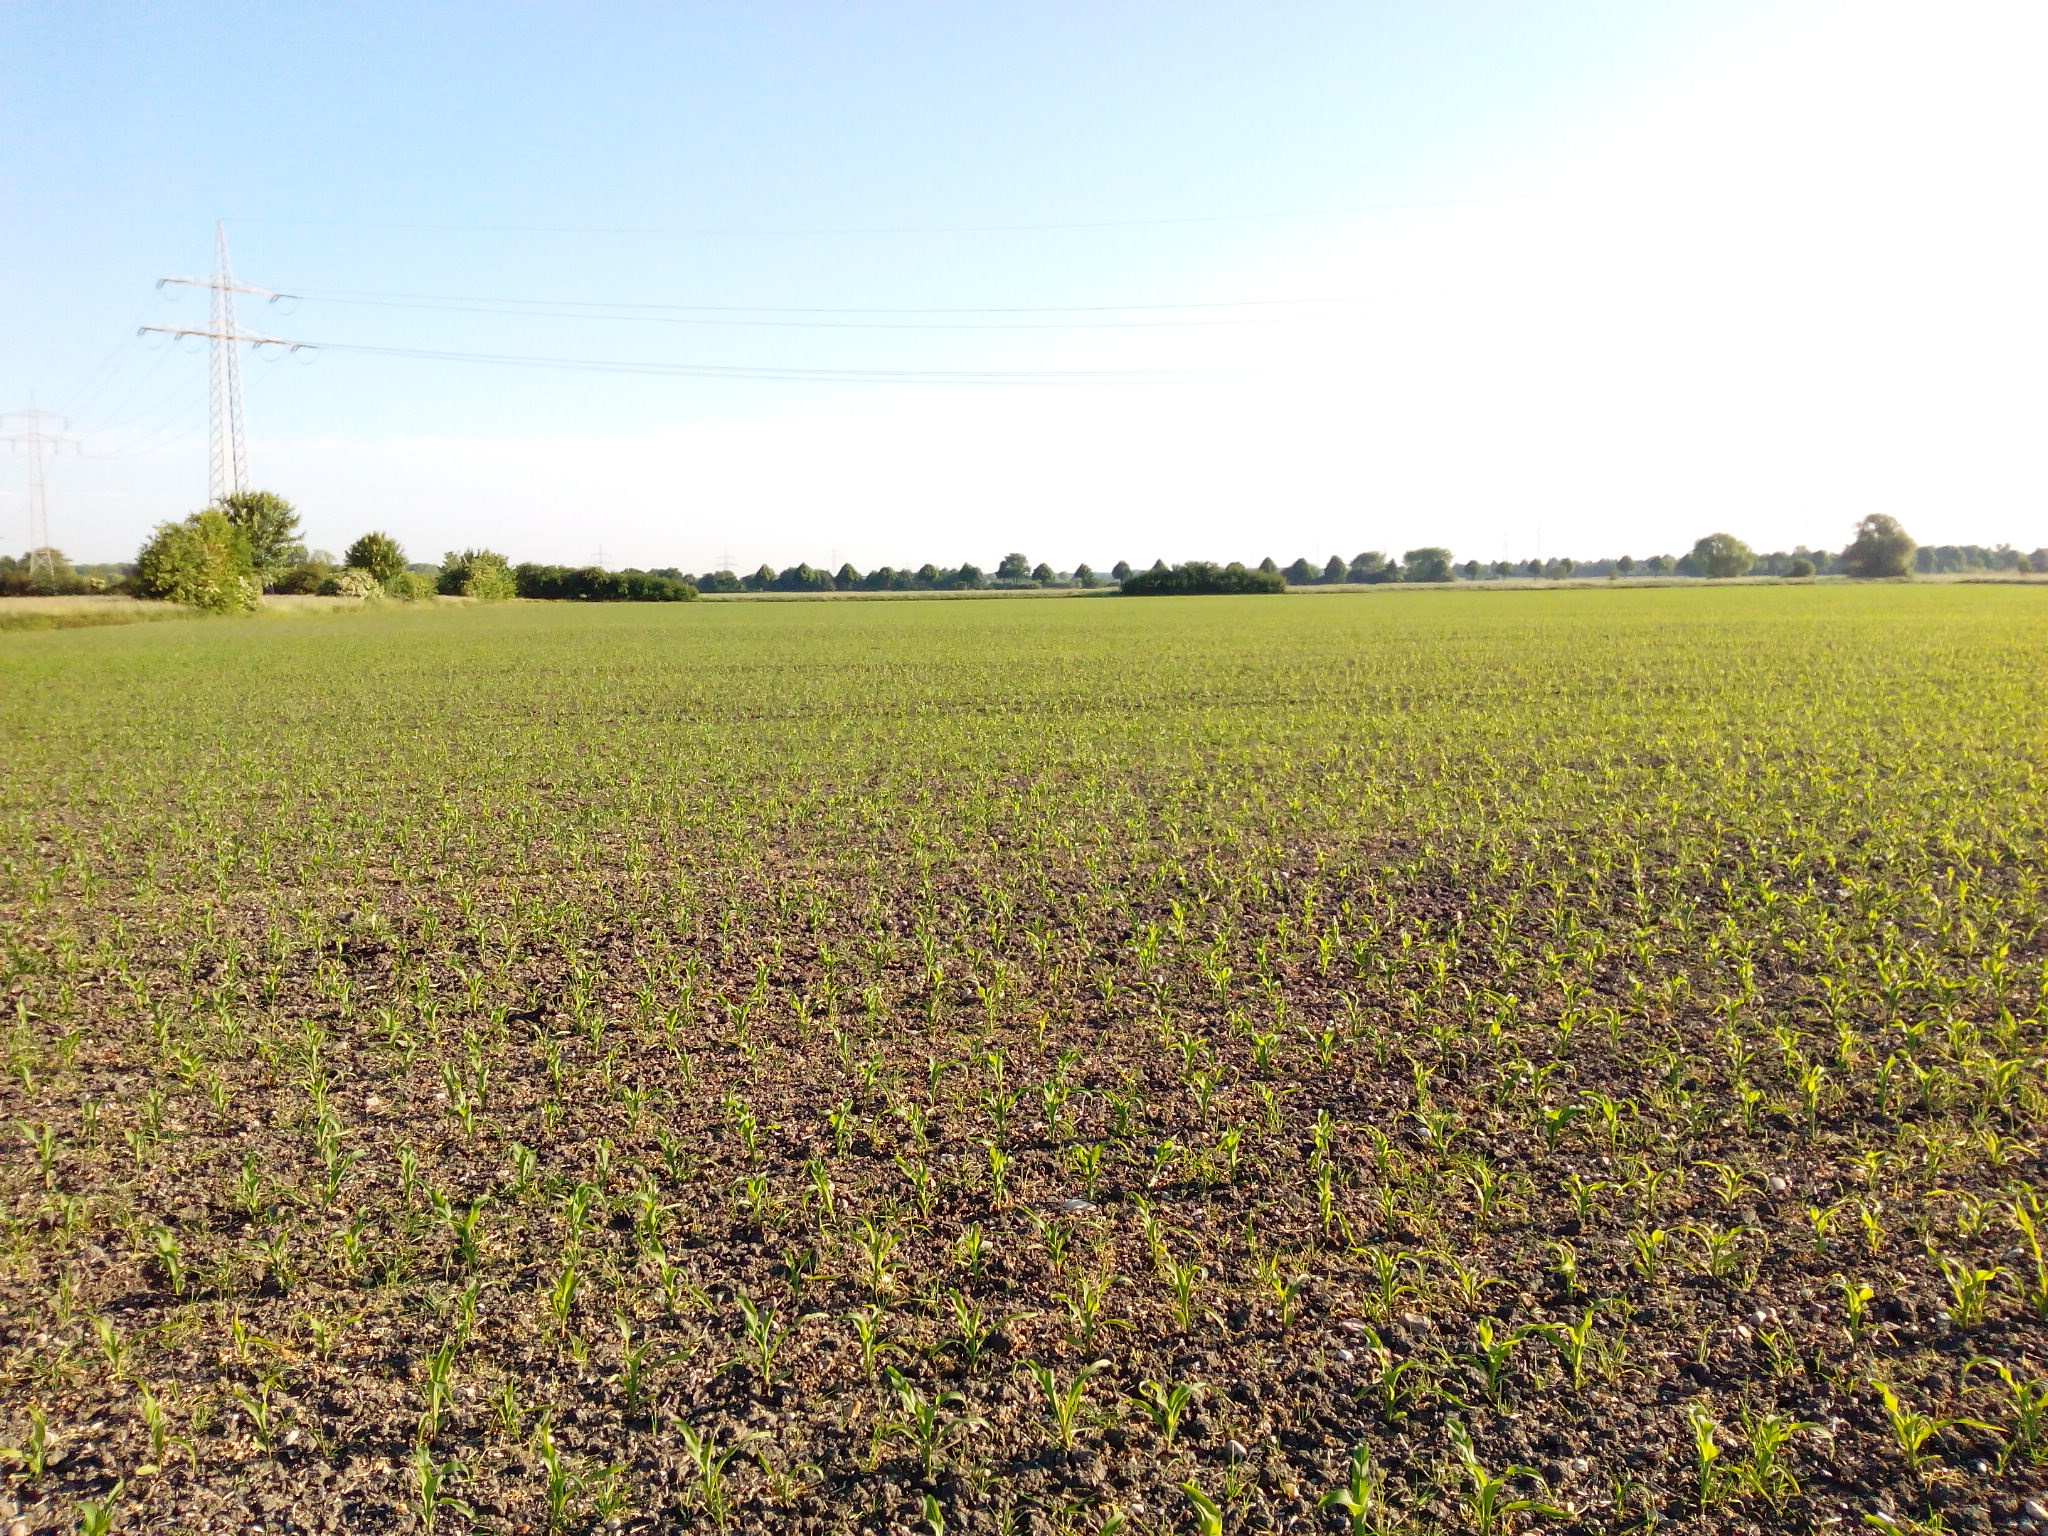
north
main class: Cropland
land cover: Maize
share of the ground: 10 - 25 %
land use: Agriculture (excluding fallow land and kitchen gardens)
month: June
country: DE
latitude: 52.3594
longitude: 9.8973
